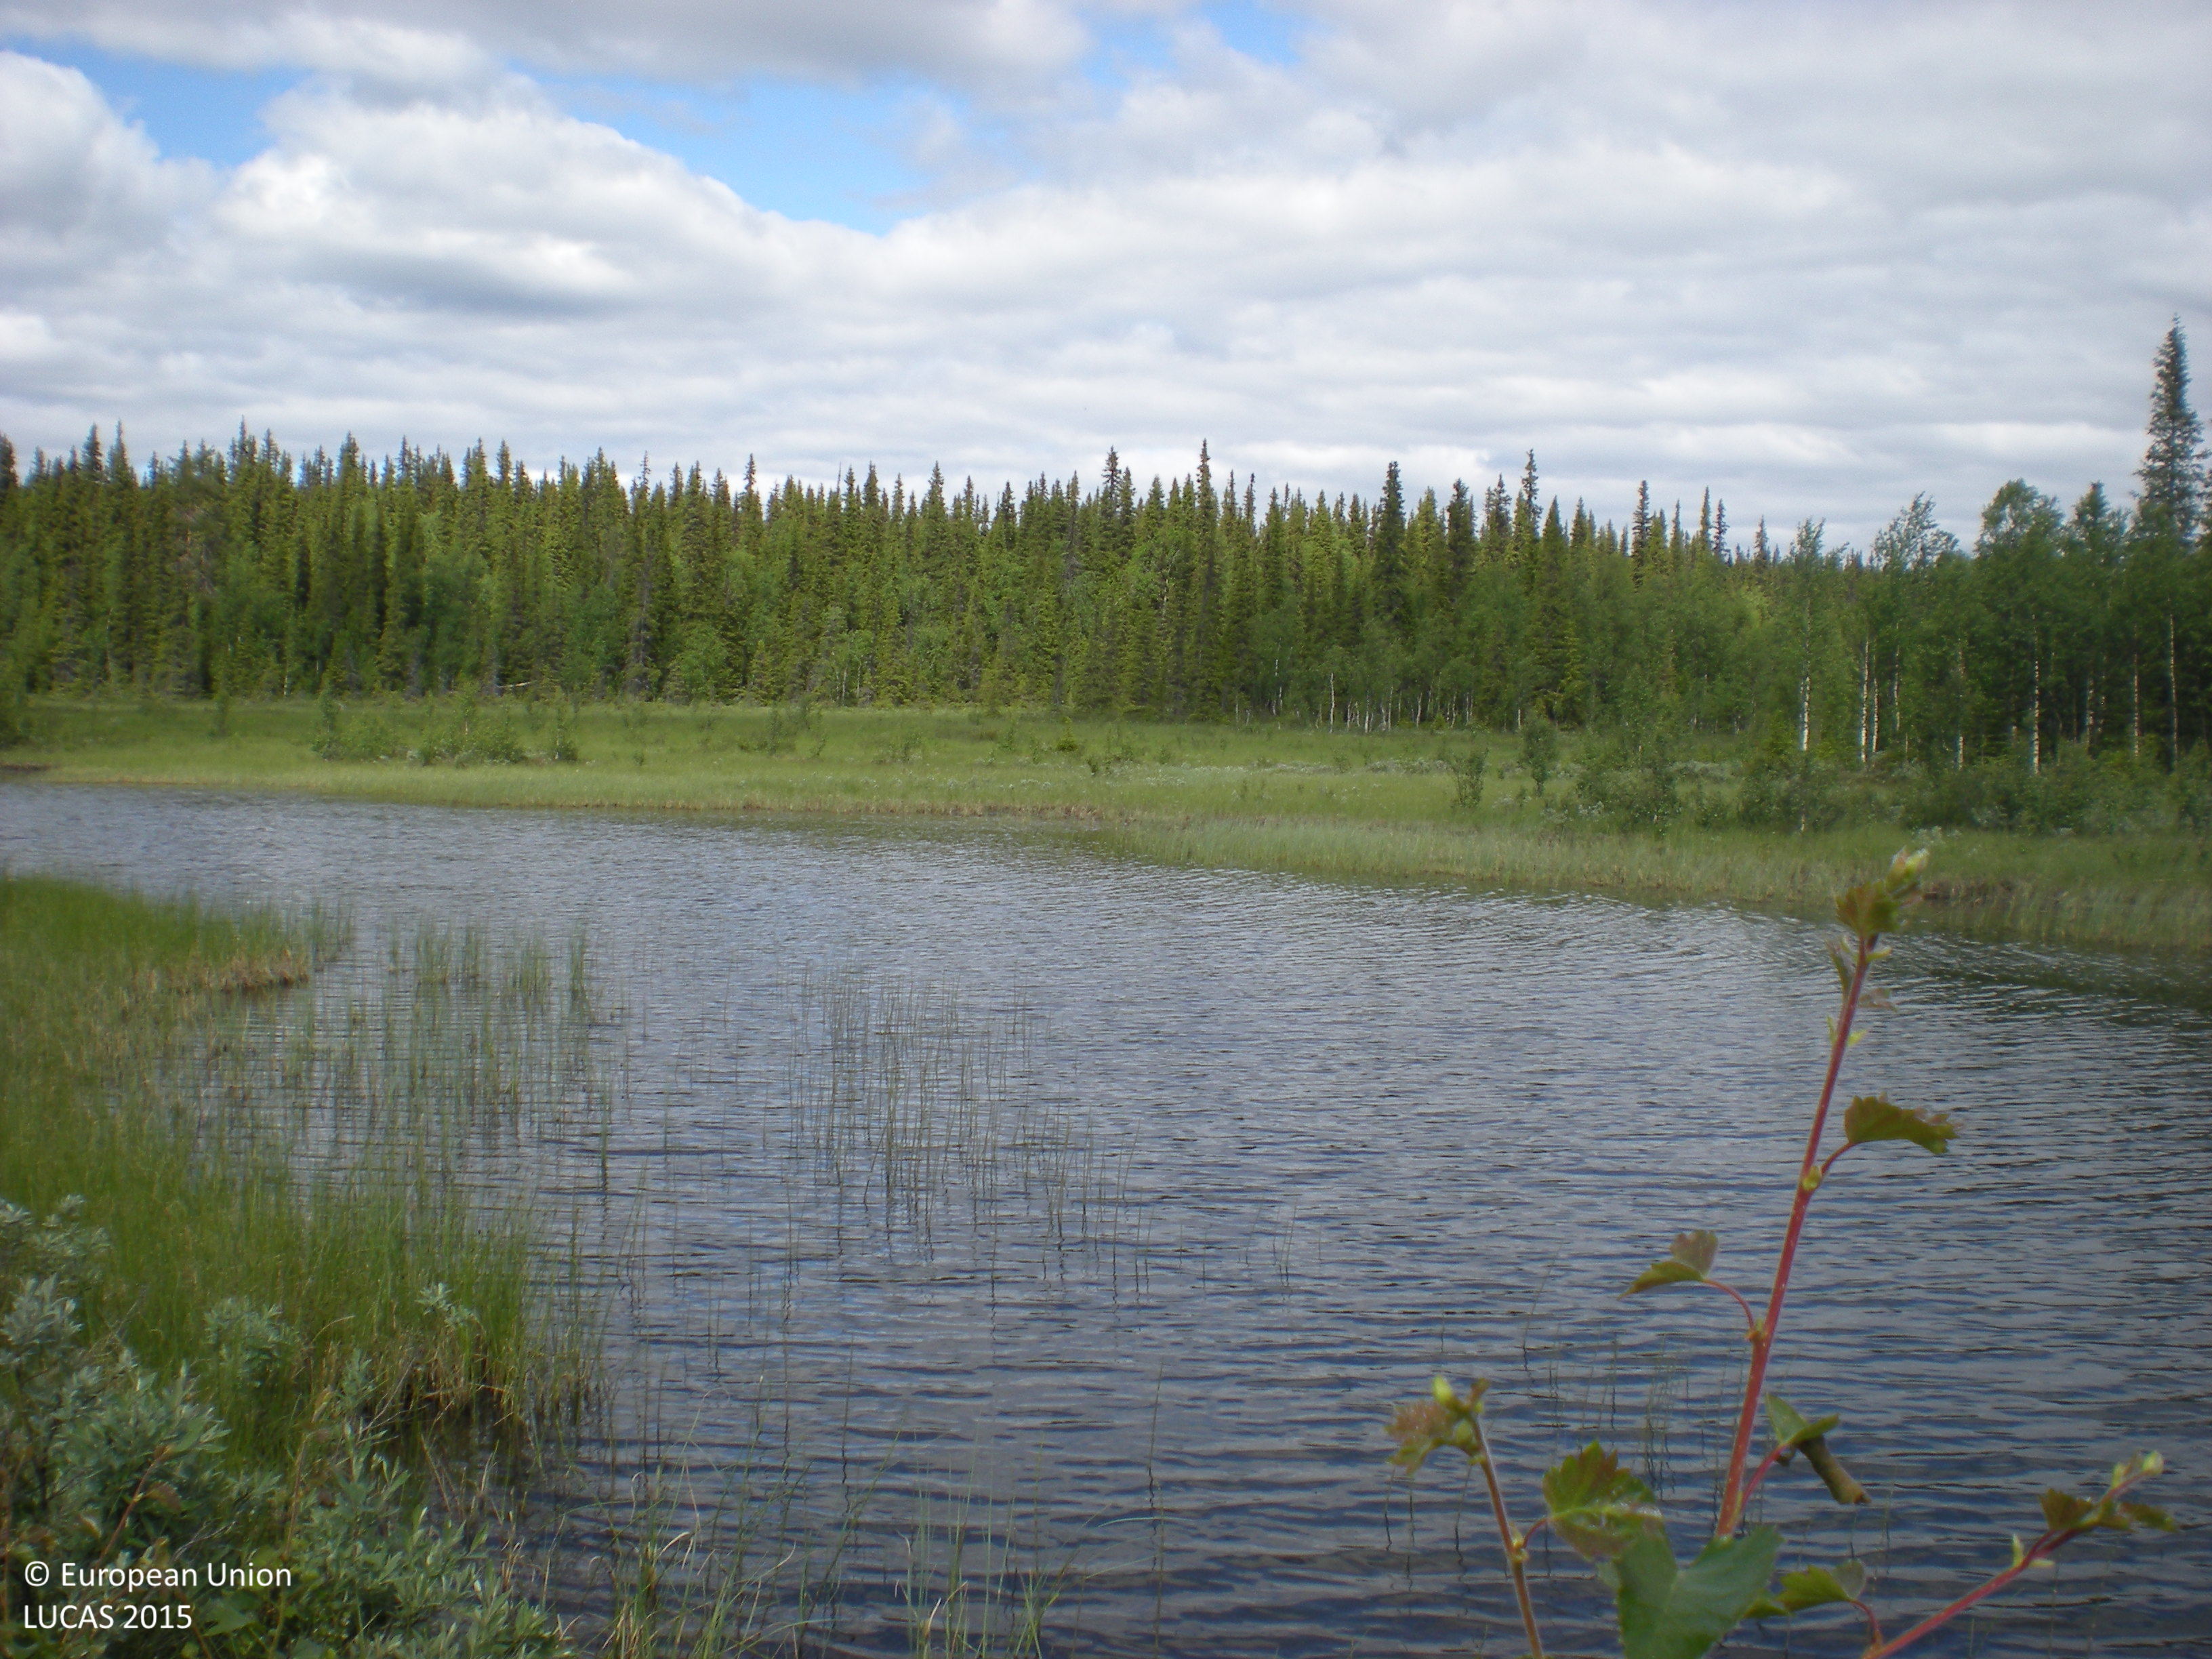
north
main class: Woodland
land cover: Broadleaved woodland
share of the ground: 10 - 25 %
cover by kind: herbaceous plants 70 %, broadleaved forest trees 30 %
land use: Semi-natural and natural areas not in use
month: July
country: SE
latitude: 65.4660
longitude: 16.8460
